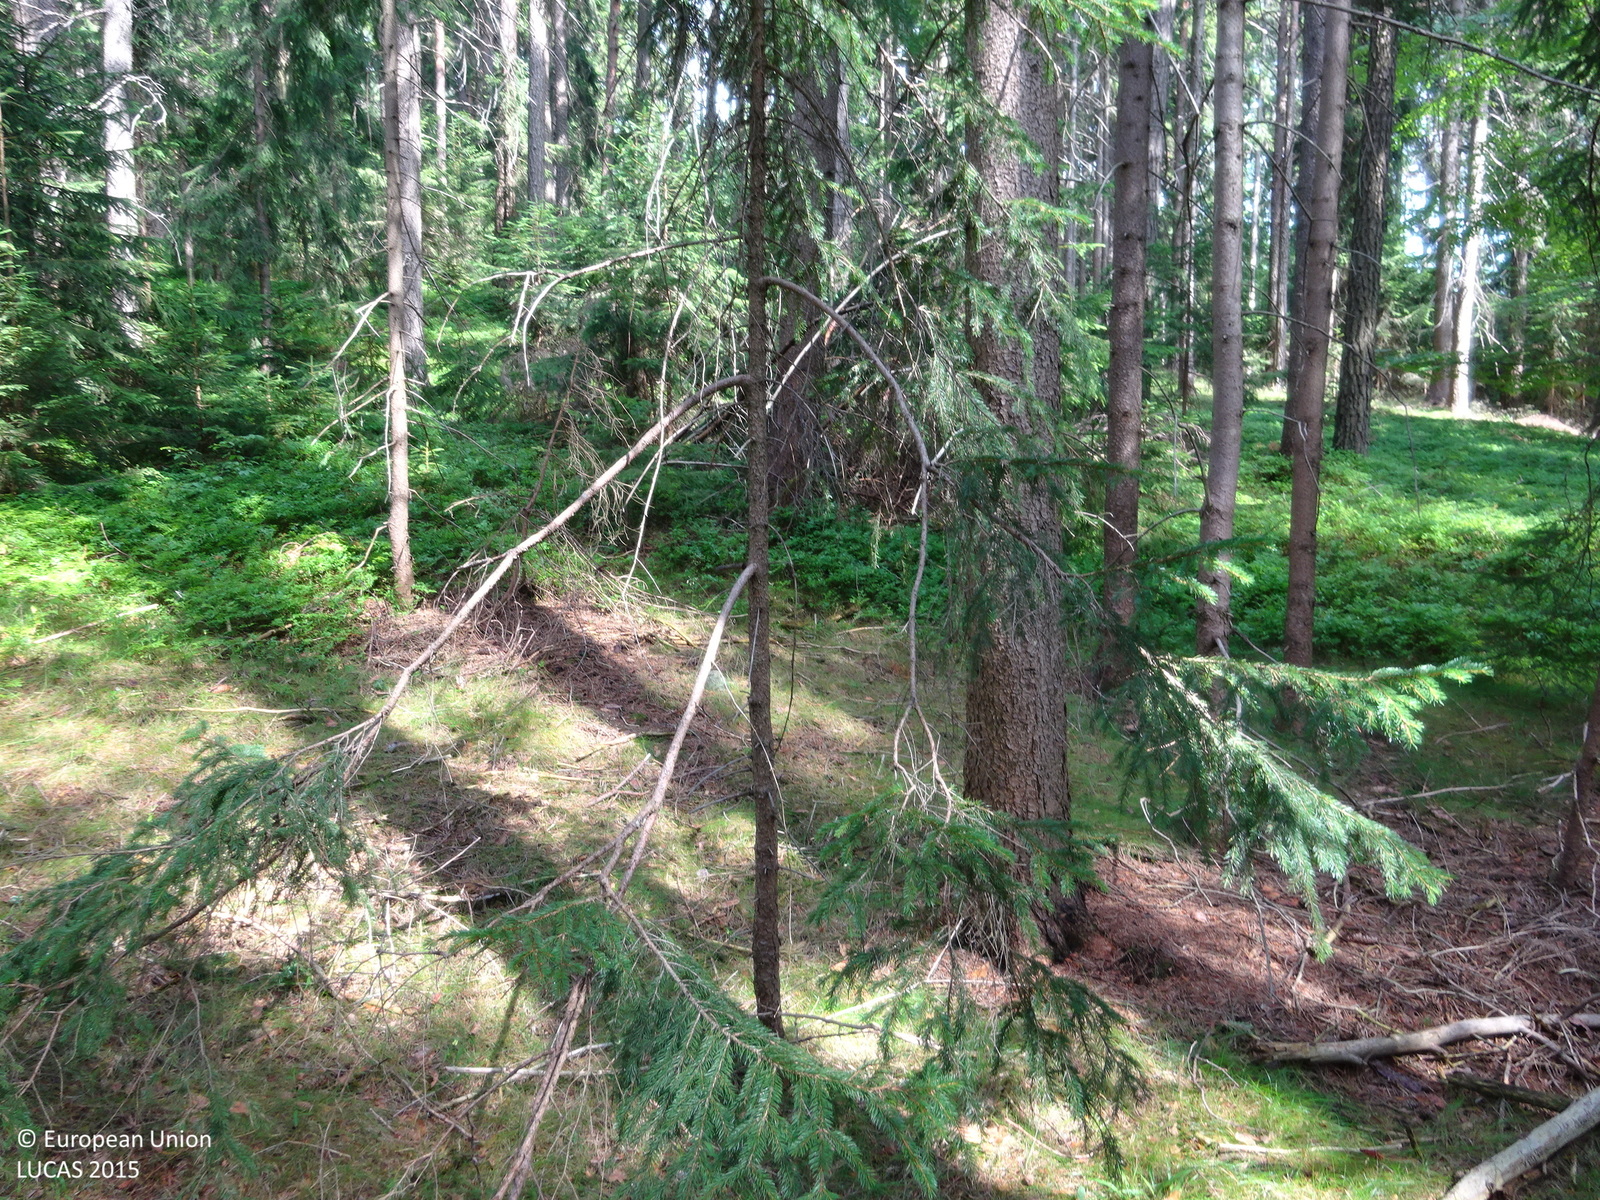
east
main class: Woodland
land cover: Spruce dominated coniferous woodland
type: alpine coniferous forest
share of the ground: > 75 %
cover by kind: coniferous forest trees 80 %, shrubs 10 %, herbaceous plants 10 %
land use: Forestry
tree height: > 5 m
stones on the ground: < 10 %
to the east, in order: Spruce dominated coniferous woodland; Tracks; Spruce dominated coniferous woodland
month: July
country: AT
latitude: 47.2240
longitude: 15.4280
